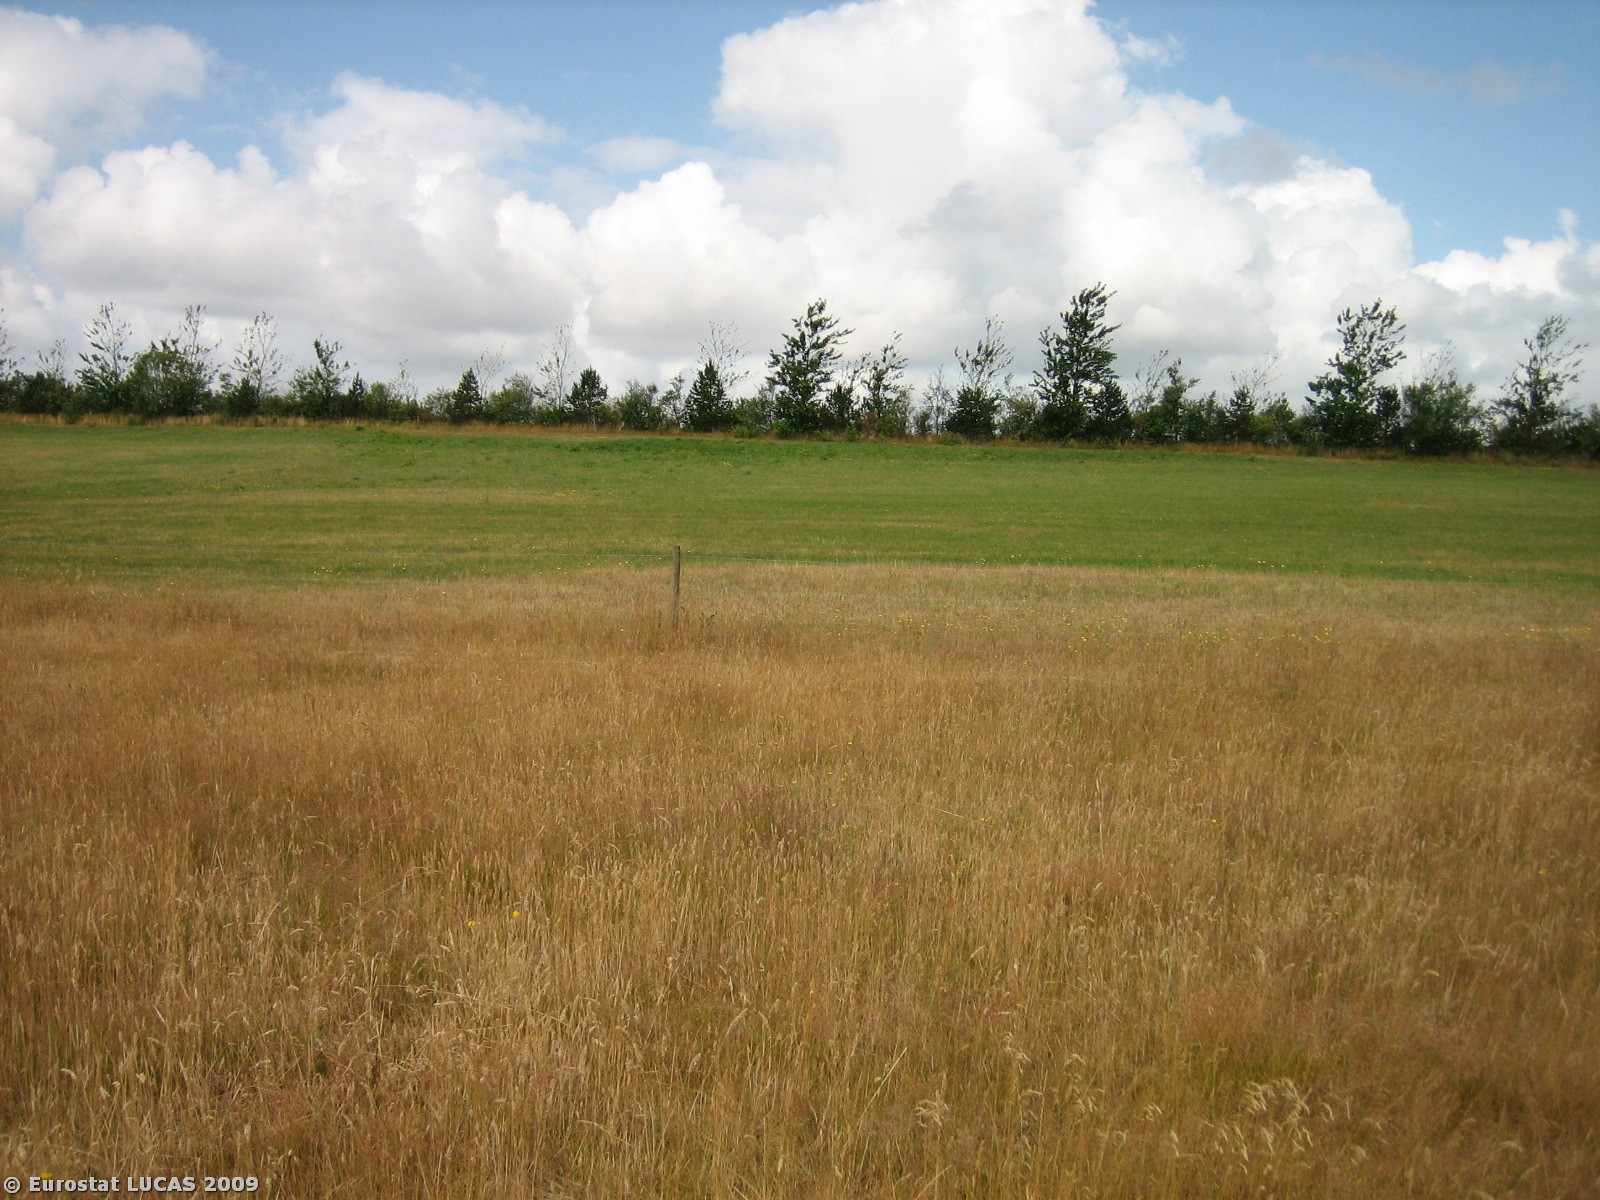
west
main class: Grassland
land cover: Grassland without tree/shrub cover
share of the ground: > 75 %
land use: Agriculture (excluding fallow land and kitchen gardens)
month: July
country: DK
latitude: 55.5661
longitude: 8.3681
